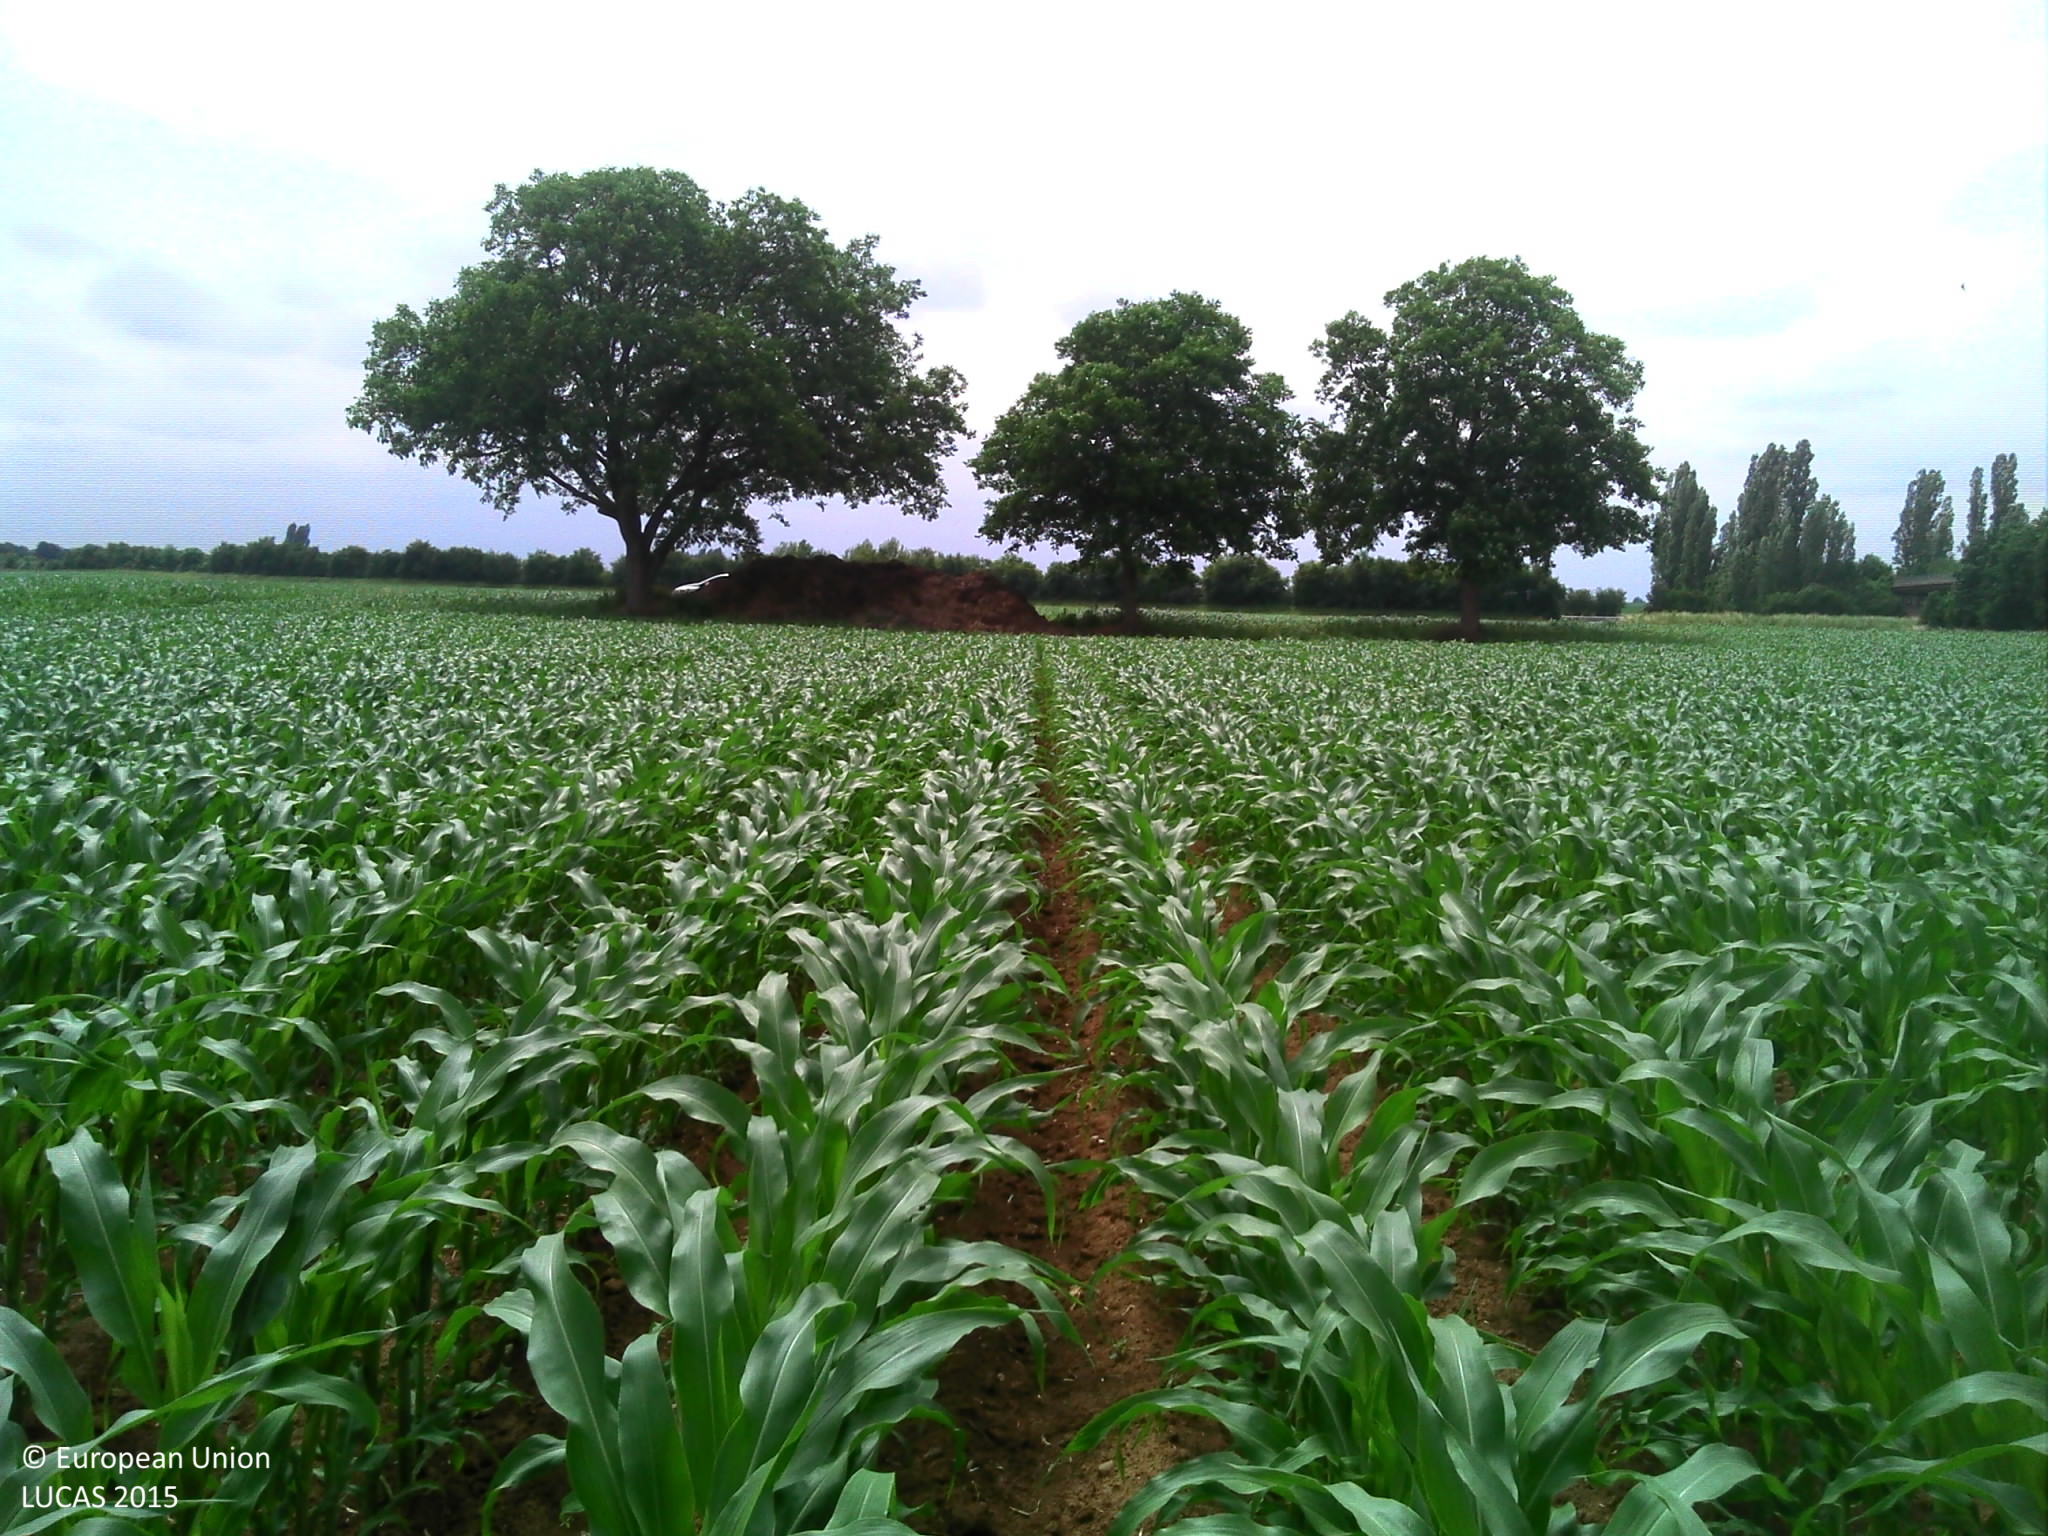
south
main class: Cropland
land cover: Maize
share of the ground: 50 - 75 %
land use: Agriculture (excluding fallow land and kitchen gardens)
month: June
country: FR
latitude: 48.5198
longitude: 7.5232
